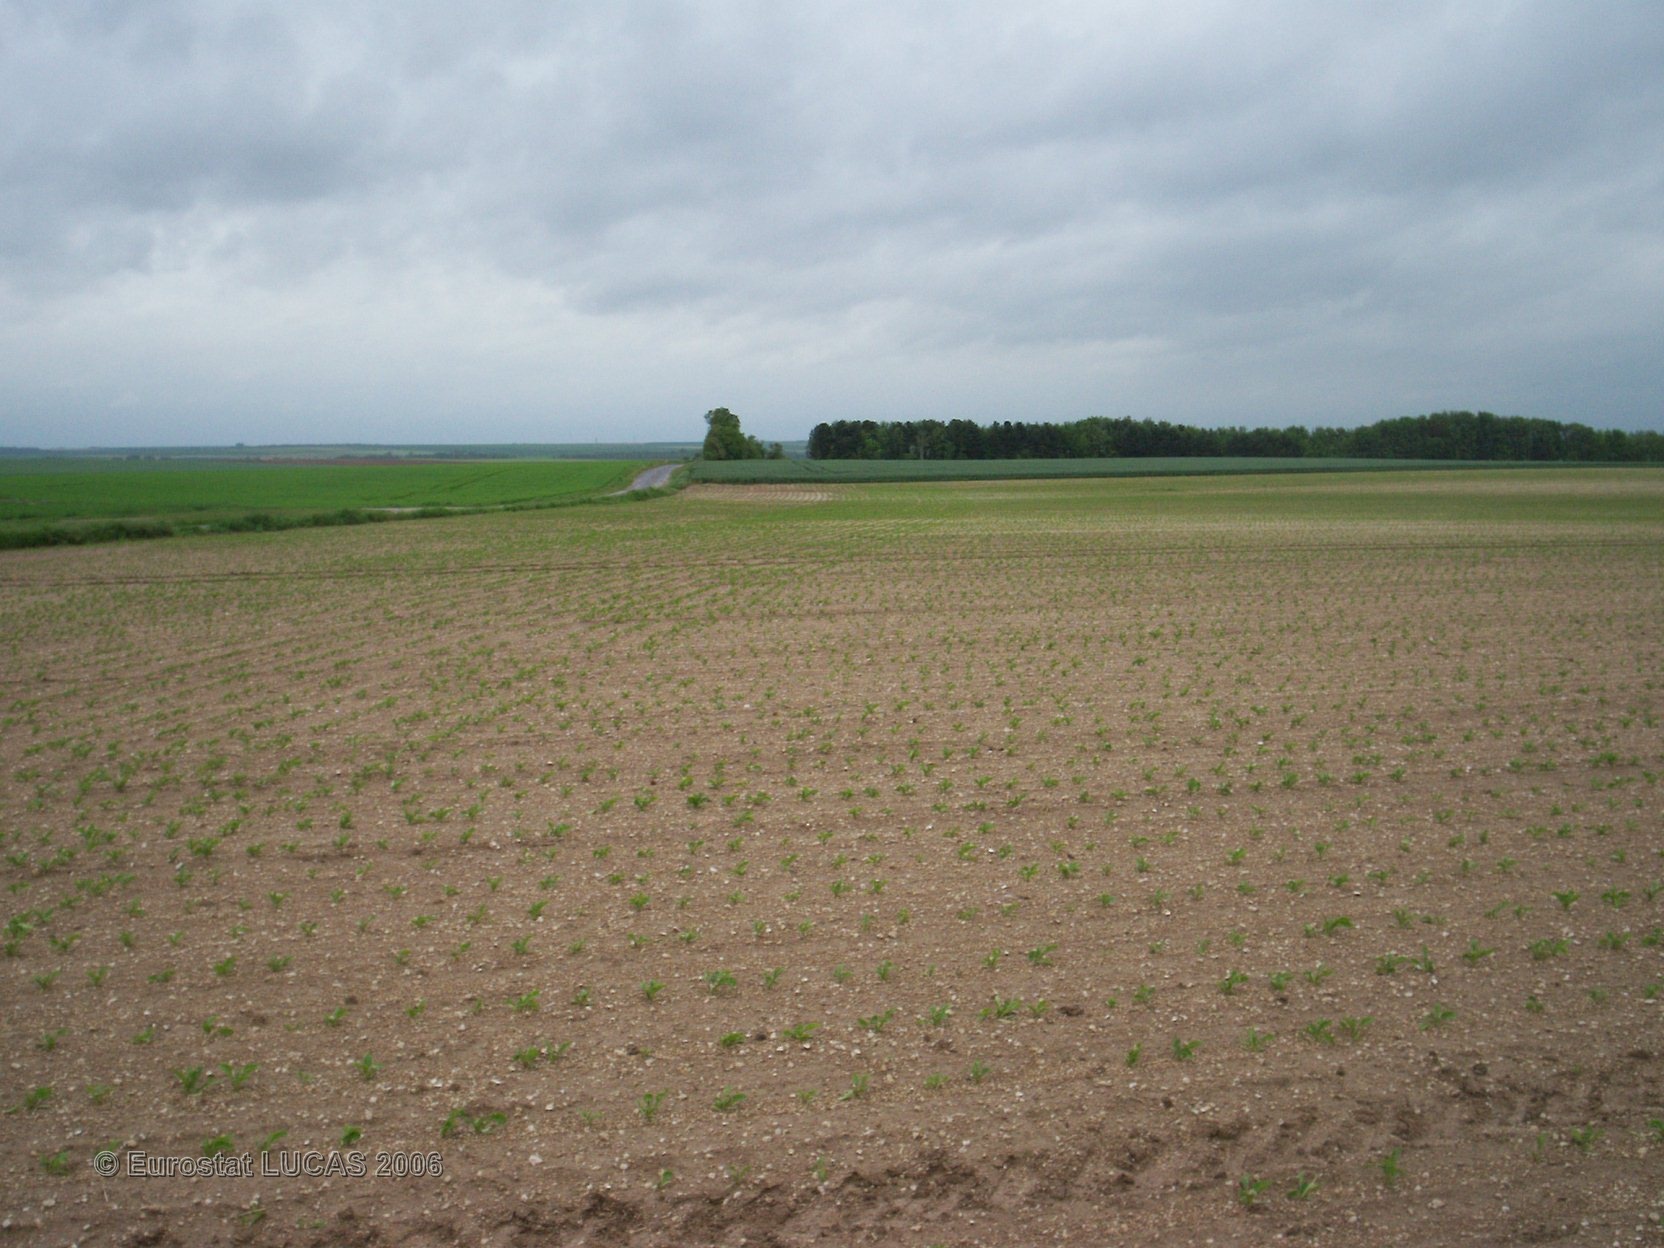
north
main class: Cropland
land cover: Sugar beet
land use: Agriculture (excluding fallow land and kitchen gardens)
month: May
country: FR
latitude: 49.3764
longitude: 4.3351
